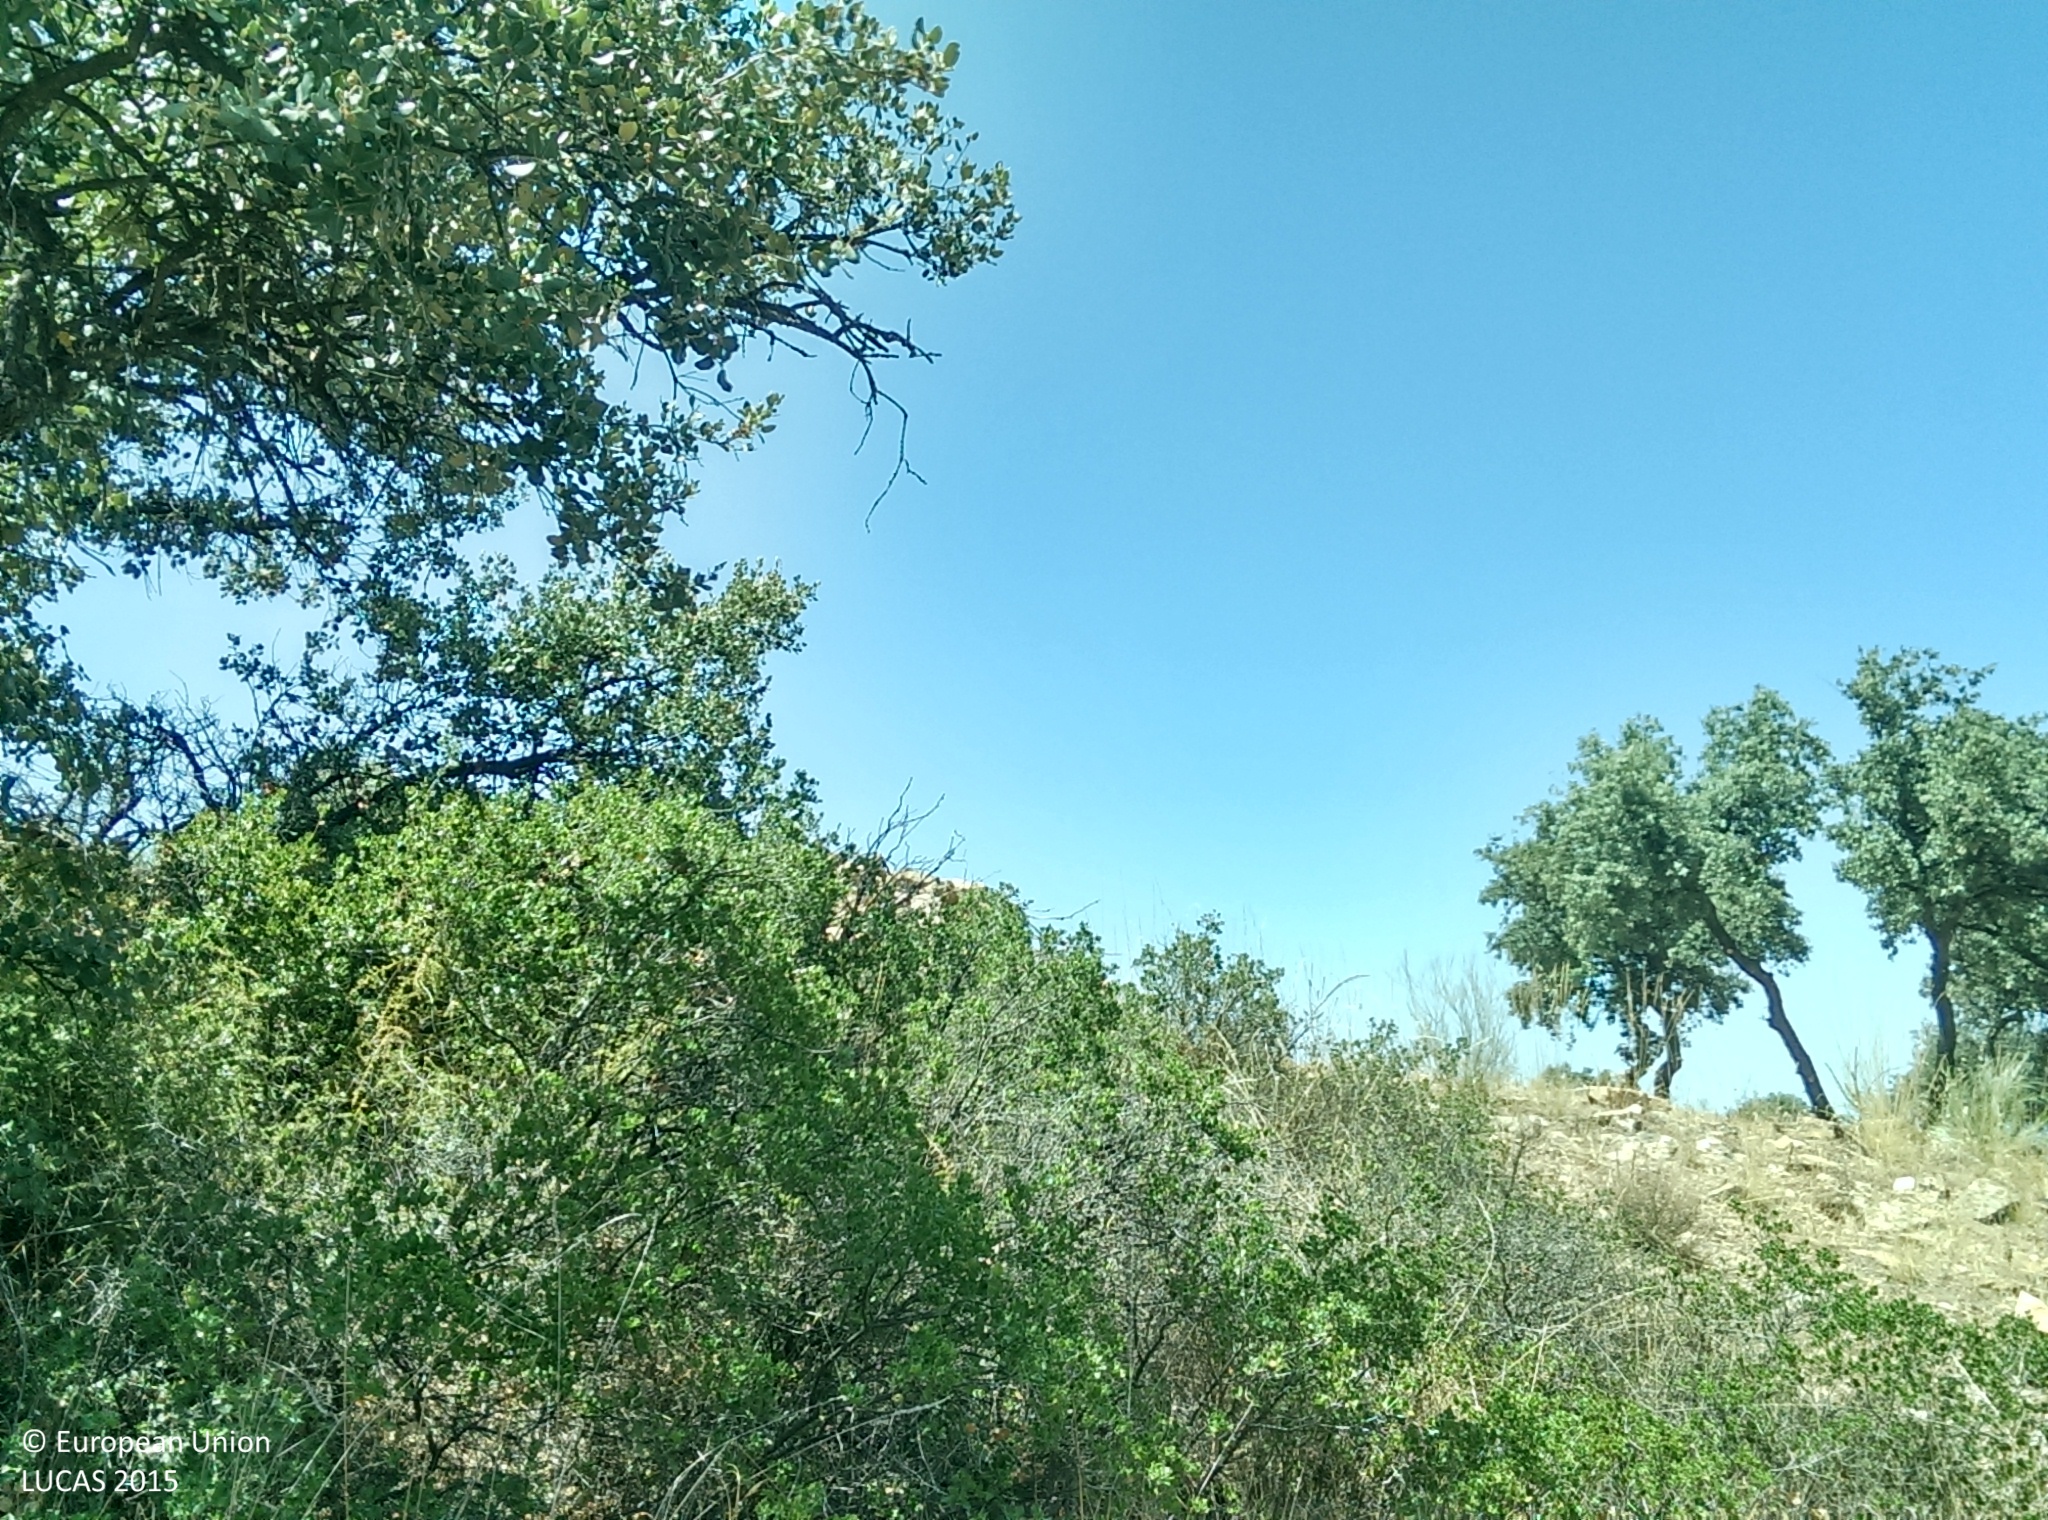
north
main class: Woodland
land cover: Broadleaved woodland
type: broadleaved evergreen forest
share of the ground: 25 - 50 %
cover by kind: broadleaved forest trees 45 %, shrubs 25 %, herbaceous plants 20 %, unconsolidated bare surface 10 %
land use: Semi-natural and natural areas not in use
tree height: < 5 m
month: July
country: ES
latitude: 37.2436
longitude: -3.2102
